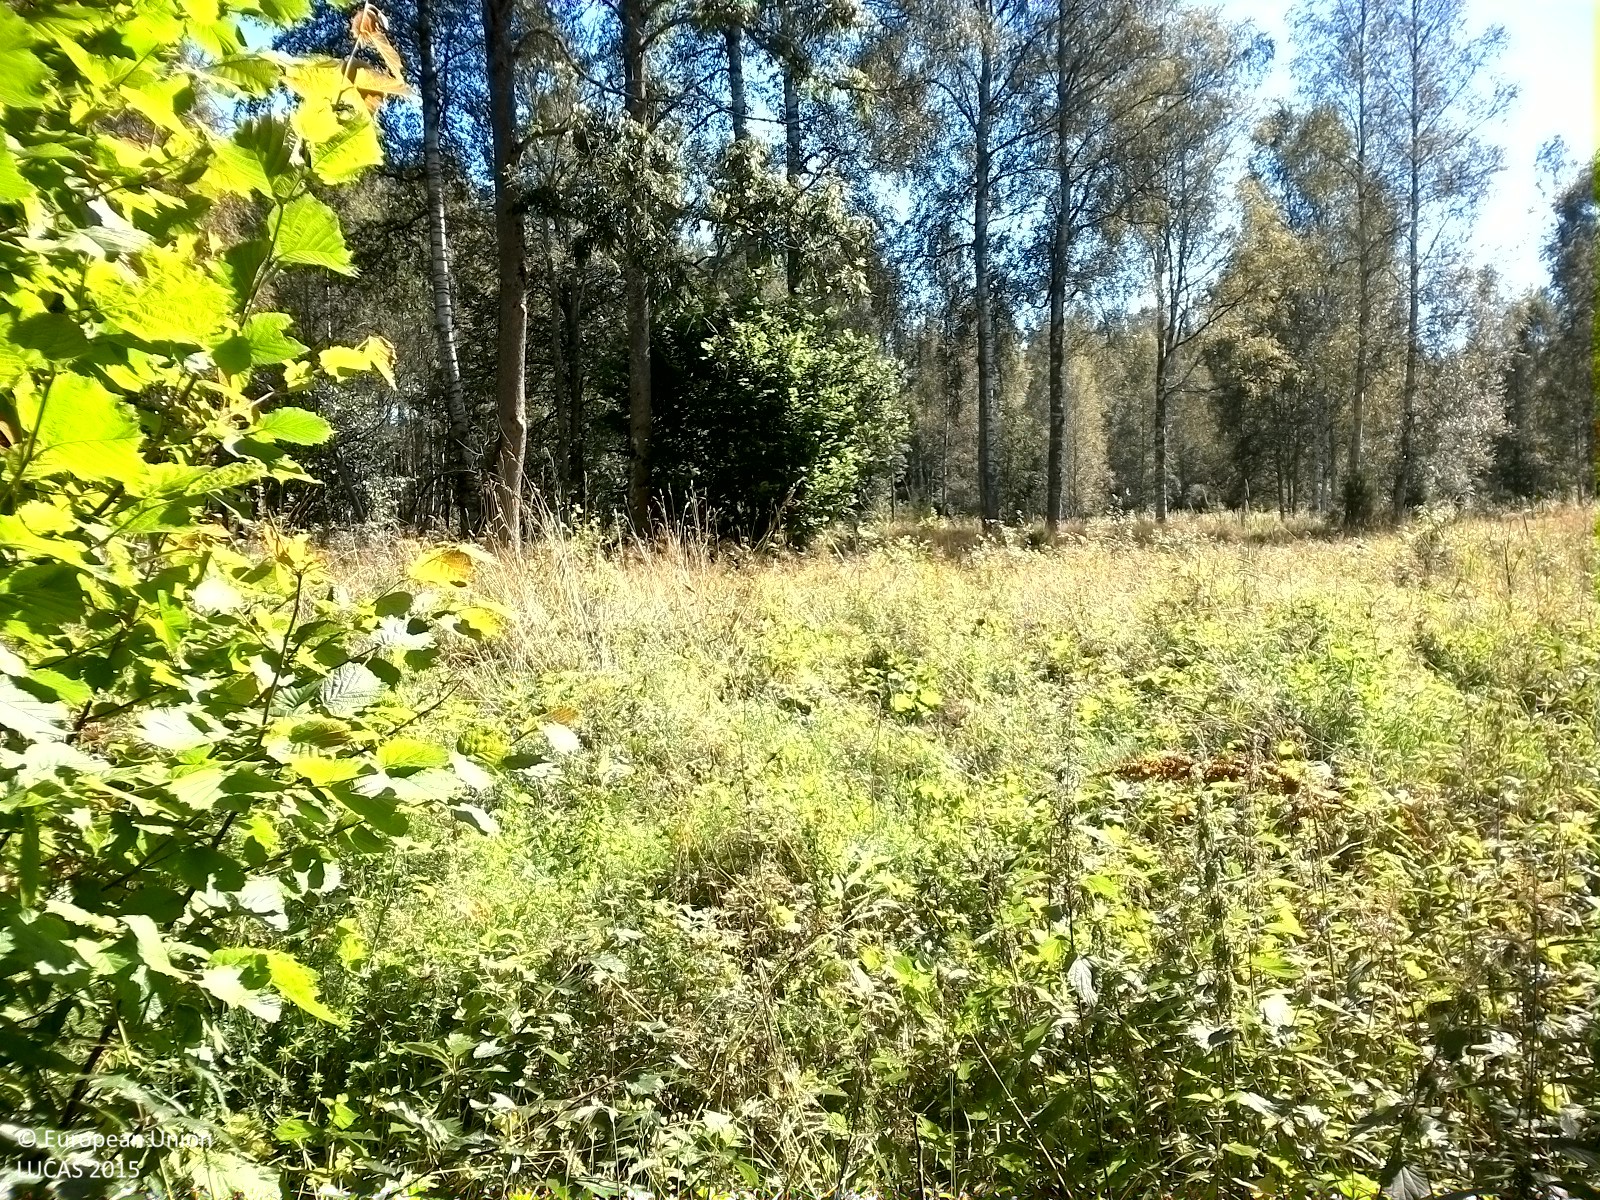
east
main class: Woodland
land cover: Broadleaved woodland
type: hemiboreal forest and nemoral coniferous forest and mixed broadleaved-coniferous forest
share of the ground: 25 - 50 %
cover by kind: herbaceous plants 55 %, broadleaved forest trees 45 %
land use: Forestry
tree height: > 5 m
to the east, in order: Broadleaved woodland; Spontaneously vegetated surfaces; Broadleaved woodland; Shrubland with sparse tree cover; Broadleaved woodland; Shrubland without tree cover; Spruce dominated mixed woodland; Rivers and streams; Spruce dominated mixed woodland
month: August
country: SE
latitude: 59.2342
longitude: 14.7764
